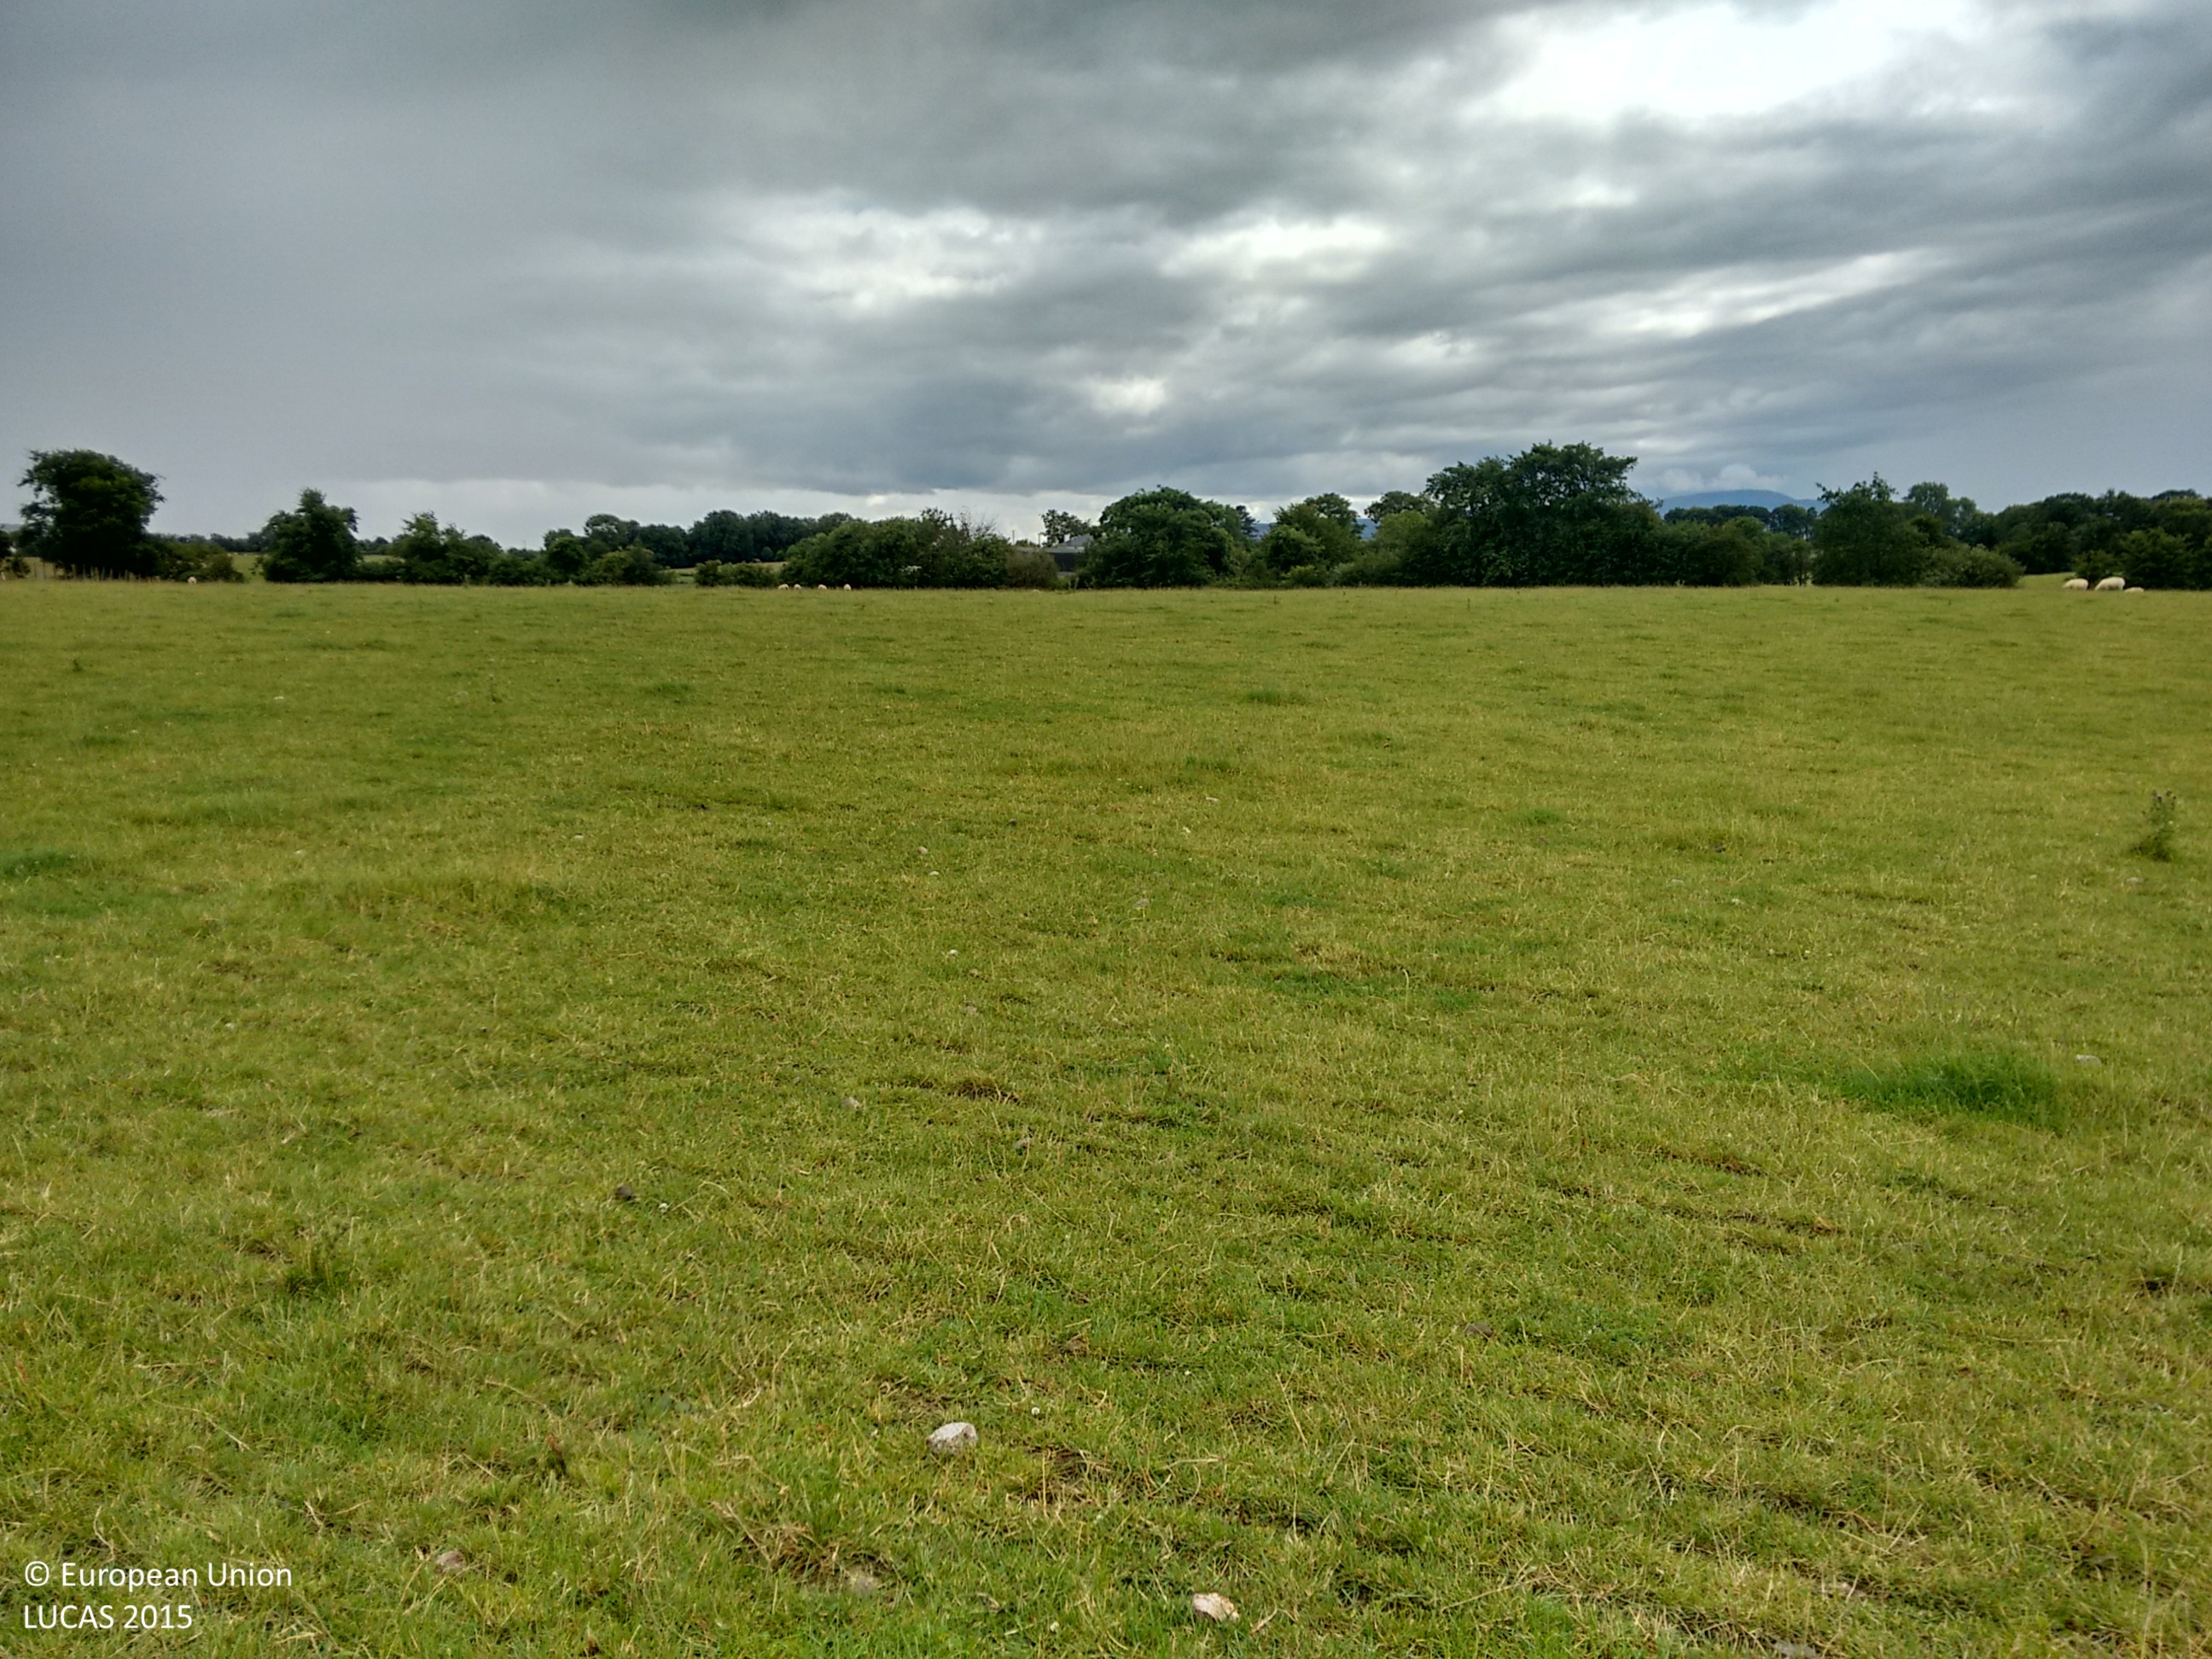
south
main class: Grassland
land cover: Grassland without tree/shrub cover
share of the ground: > 75 %
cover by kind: herbaceous plants 95 %, unconsolidated bare surface 5 %
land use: Agriculture (excluding fallow land and kitchen gardens)
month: July
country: IE
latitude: 52.7609
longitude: -6.7162
